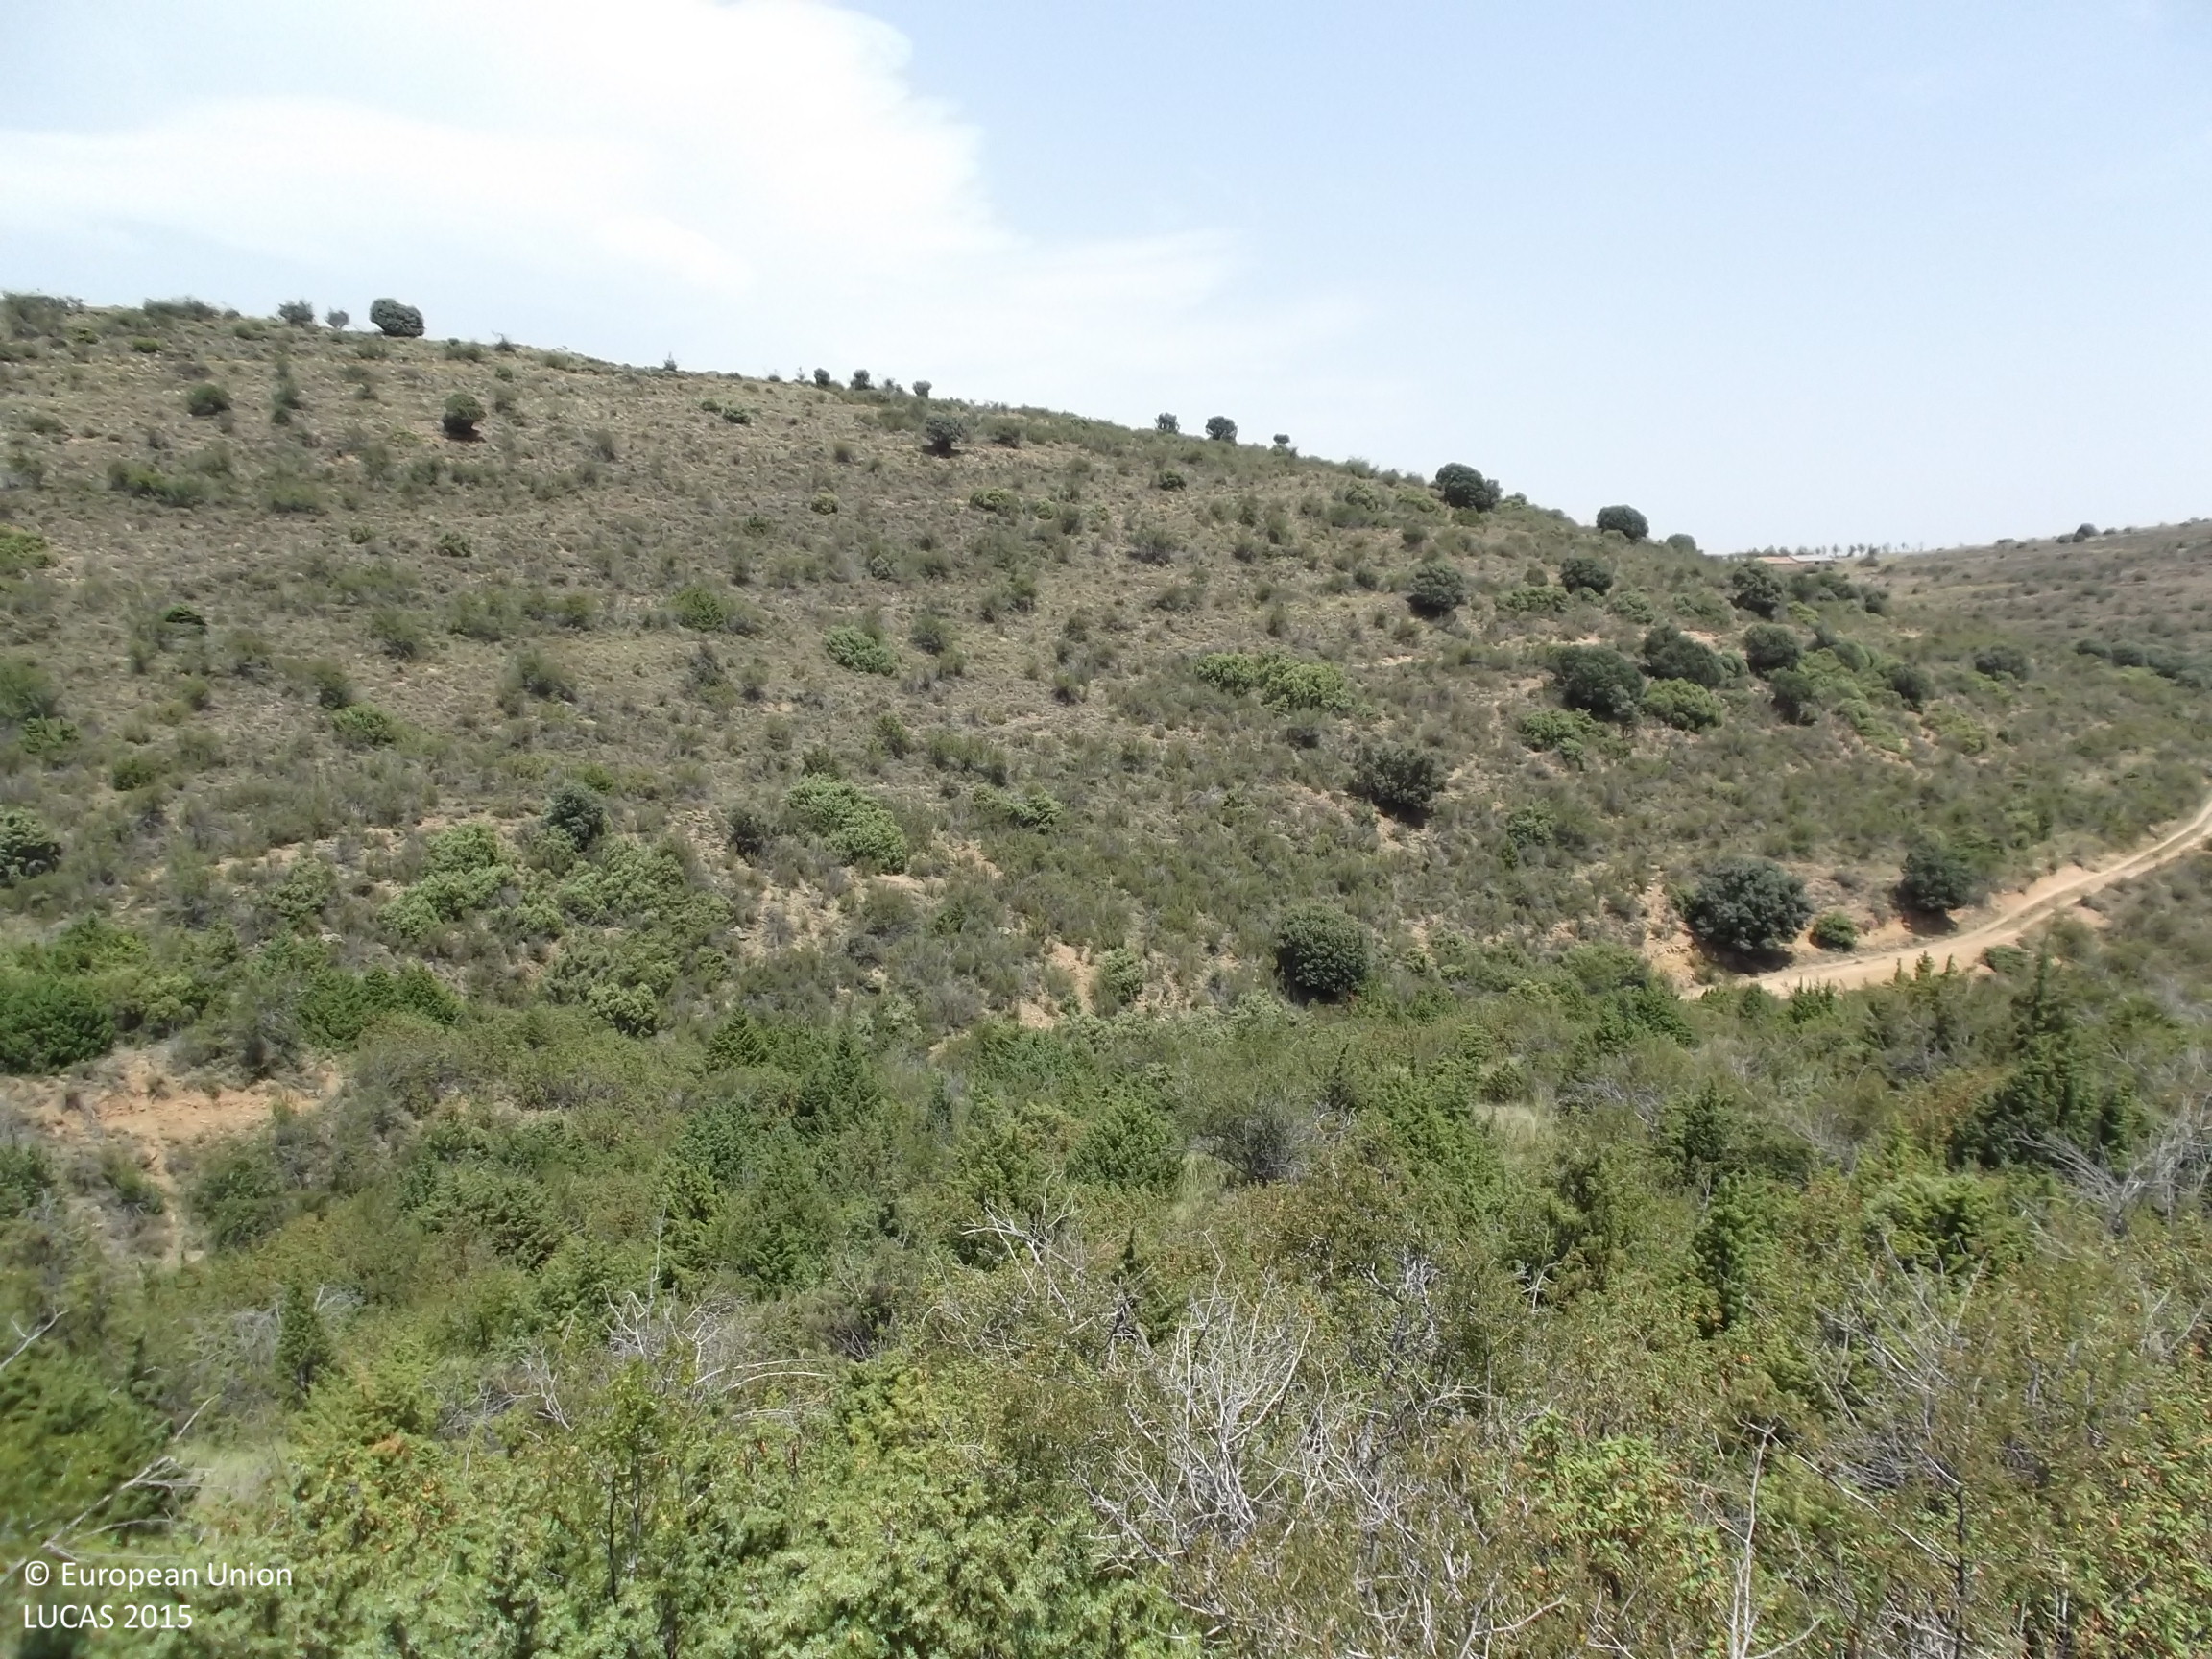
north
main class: Shrubland
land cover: Shrubland with sparse tree cover
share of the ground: > 75 %
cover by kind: shrubs 80 %, unconsolidated bare surface 15 %, broadleaved forest trees 5 %
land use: Agriculture (excluding fallow land and kitchen gardens)
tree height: < 5 m
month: July
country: ES
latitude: 42.0227
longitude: -2.0527
